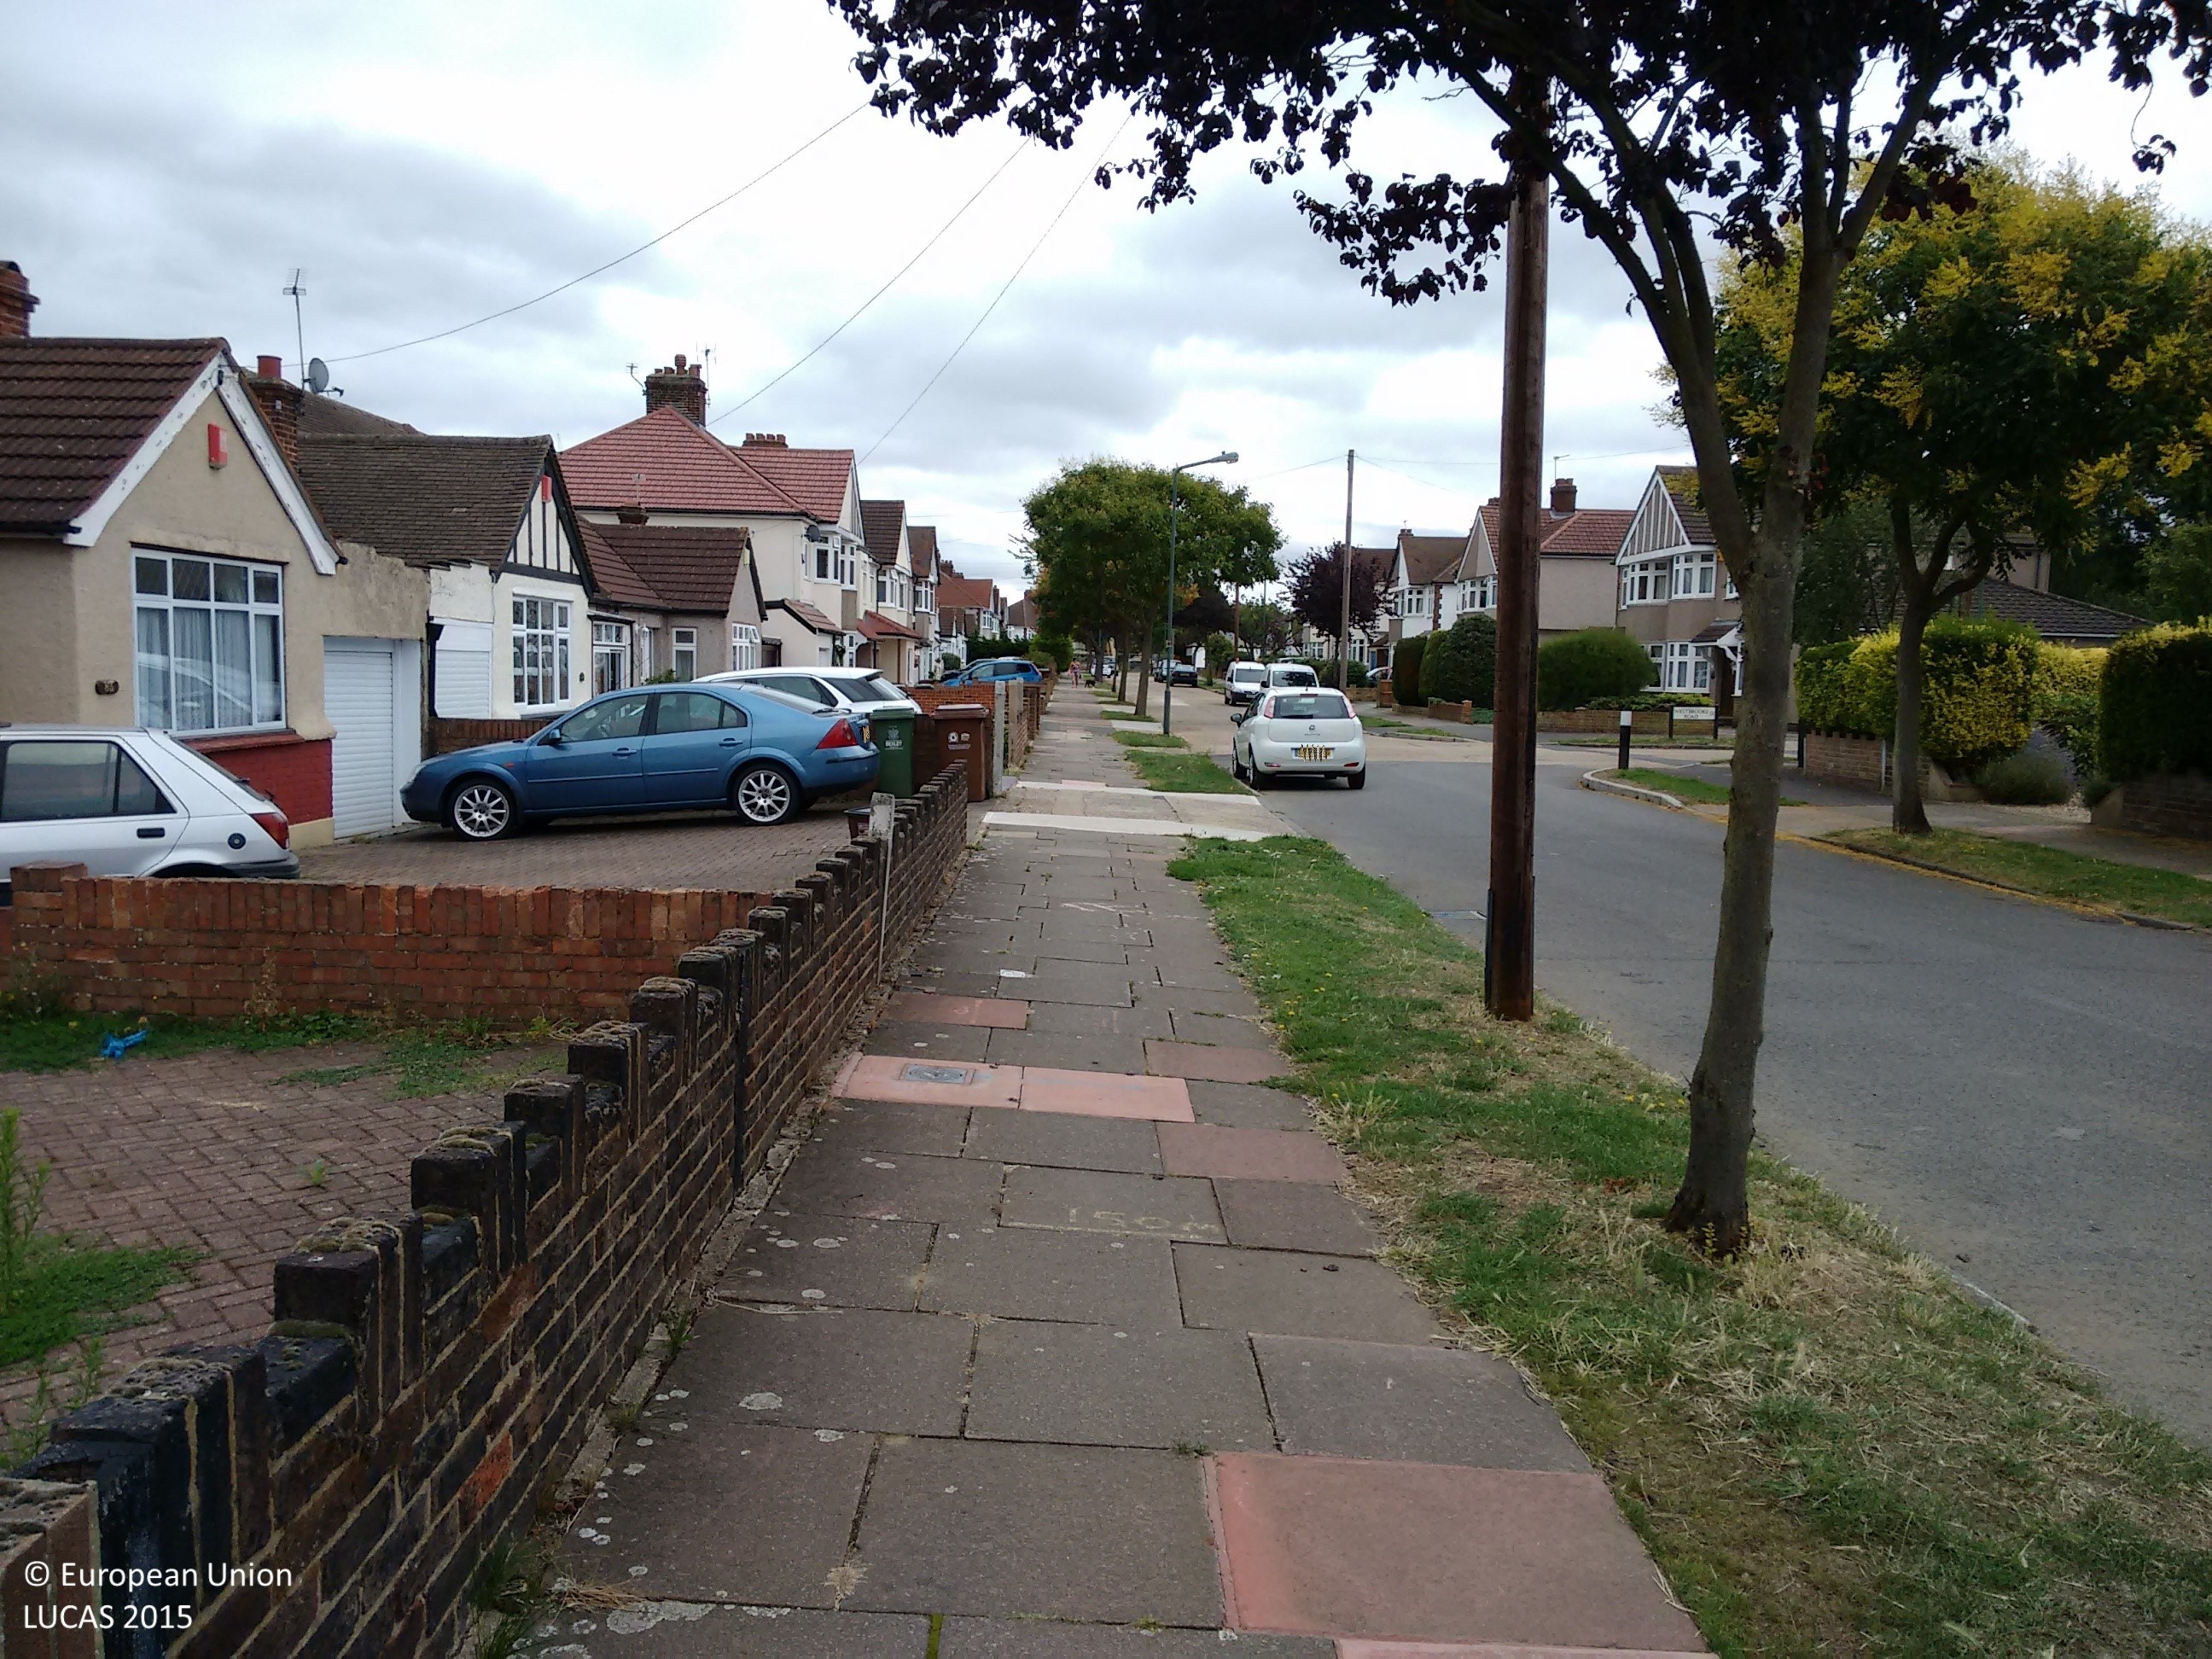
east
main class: Cropland
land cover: Other fresh vegetables
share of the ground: > 75 %
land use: Kitchen garden
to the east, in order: Other fresh vegetables; Broadleaved woodland; Fences; Railways; Fences; Broadleaved woodland; Grassland without tree/shrub cover; Broadleaved woodland
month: August
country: GB
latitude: 51.4361
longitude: 0.0853
